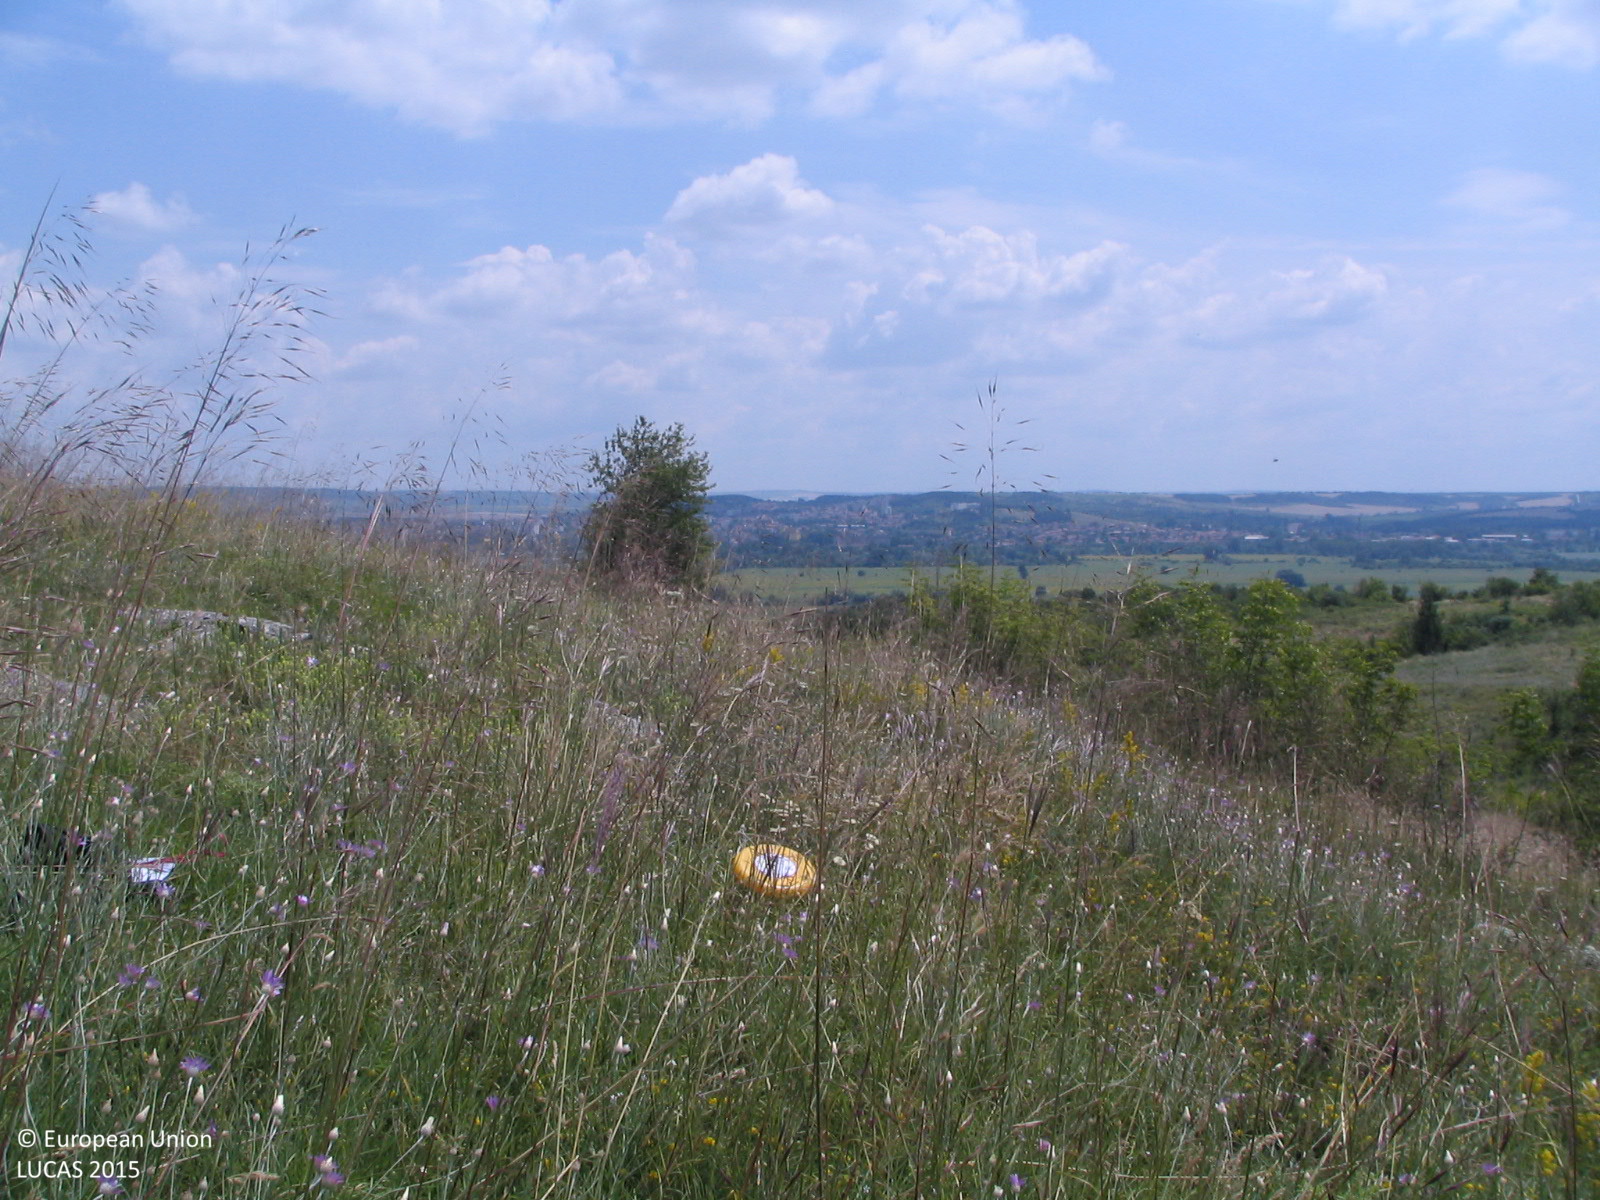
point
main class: Grassland
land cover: Grassland with sparse tree/shrub cover
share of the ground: > 75 %
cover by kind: herbaceous plants 85 %, shrubs 10 %, broadleaved forest trees 5 %
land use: Agriculture (excluding fallow land and kitchen gardens)
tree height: < 5 m
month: June
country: BG
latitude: 43.2811
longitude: 24.0379
